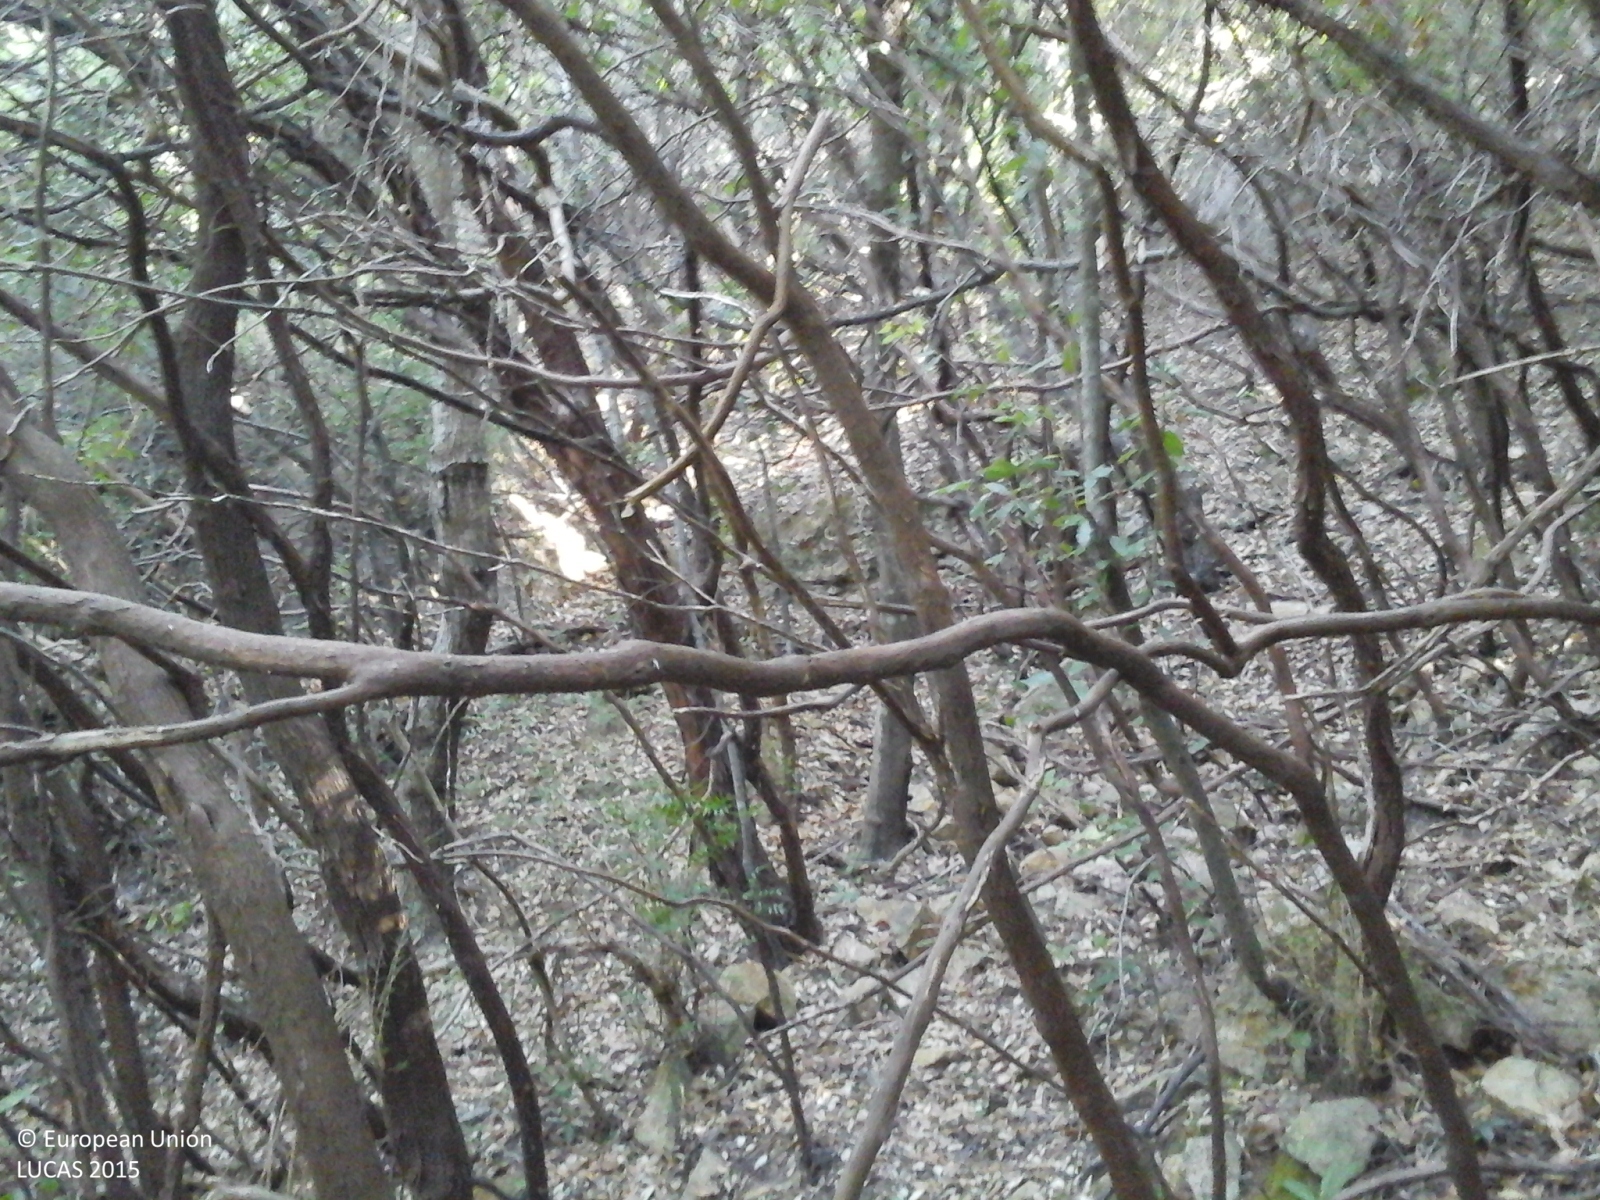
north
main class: Woodland
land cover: Broadleaved woodland
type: broadleaved evergreen forest
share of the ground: > 75 %
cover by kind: broadleaved forest trees 100 %
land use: Semi-natural and natural areas not in use
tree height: > 5 m
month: July
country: IT
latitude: 42.8162
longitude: 10.2804
